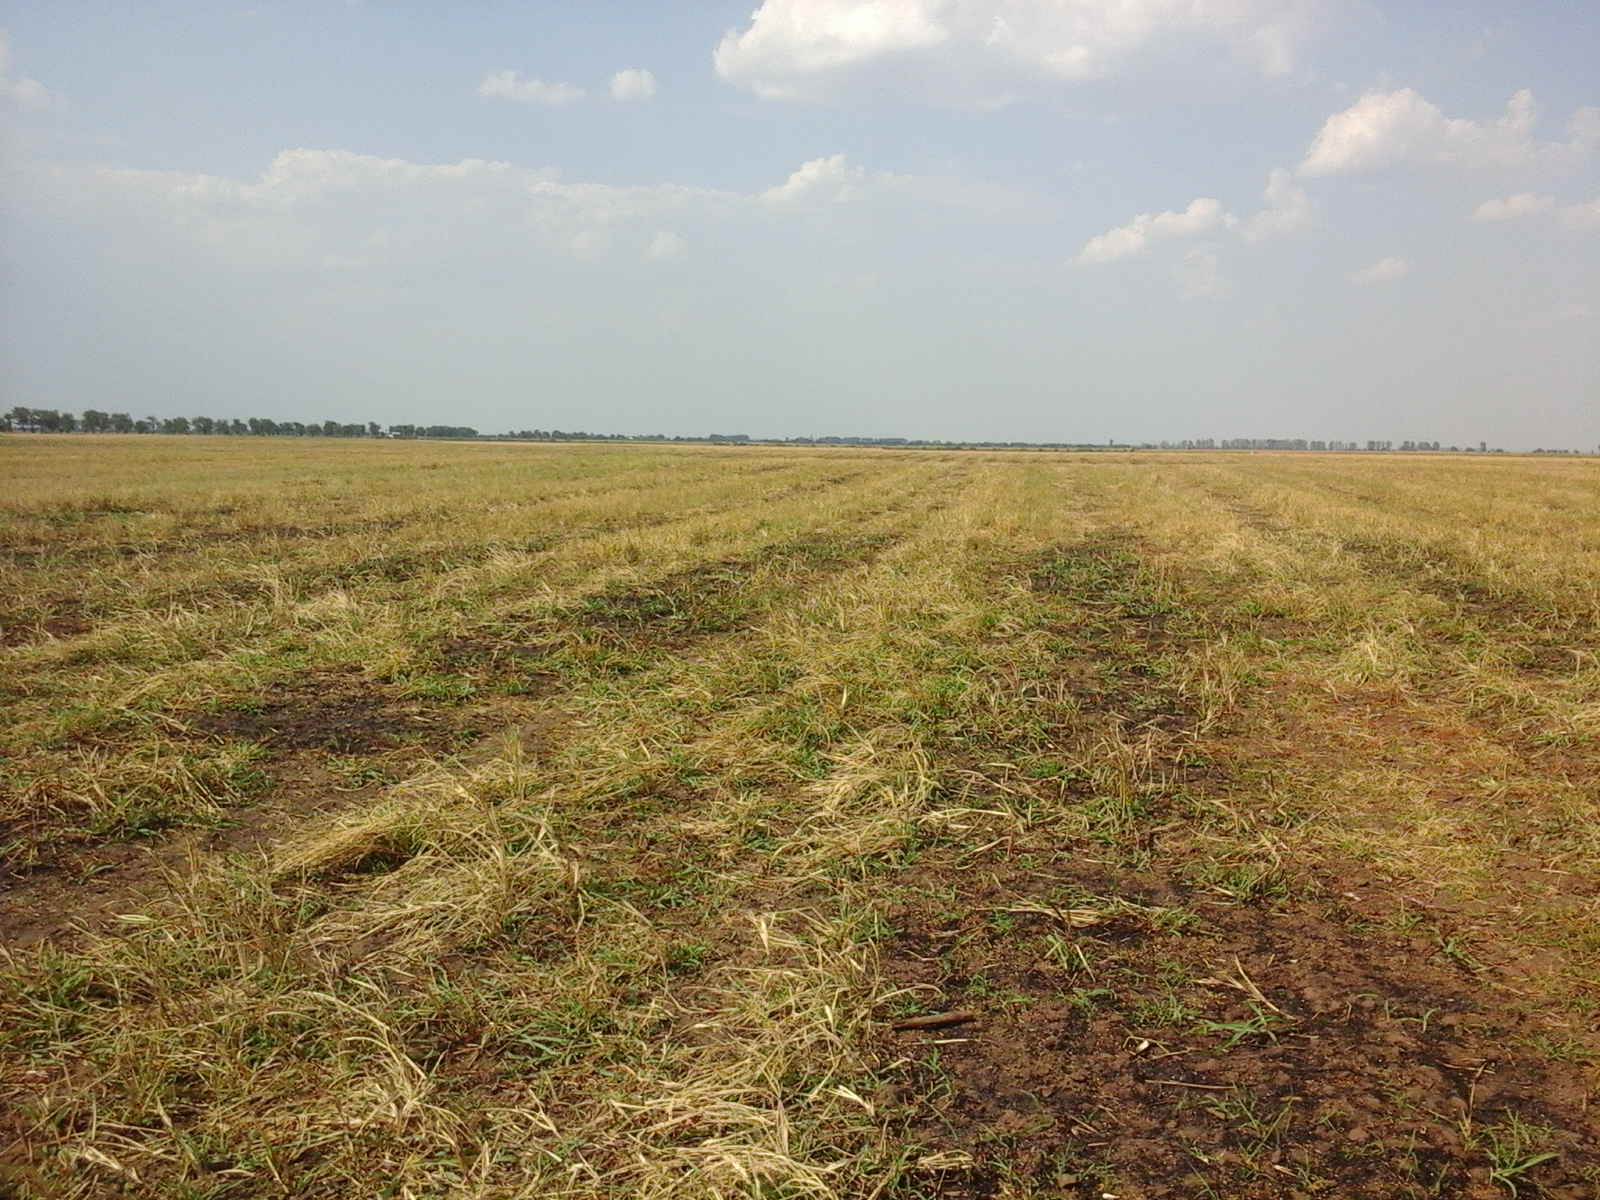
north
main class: Cropland
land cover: Common wheat
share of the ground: 50 - 75 %
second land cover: Spontaneously vegetated surfaces
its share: > 75 %
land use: Agriculture (excluding fallow land and kitchen gardens)
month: August
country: RO
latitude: 43.9850
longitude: 23.4257
